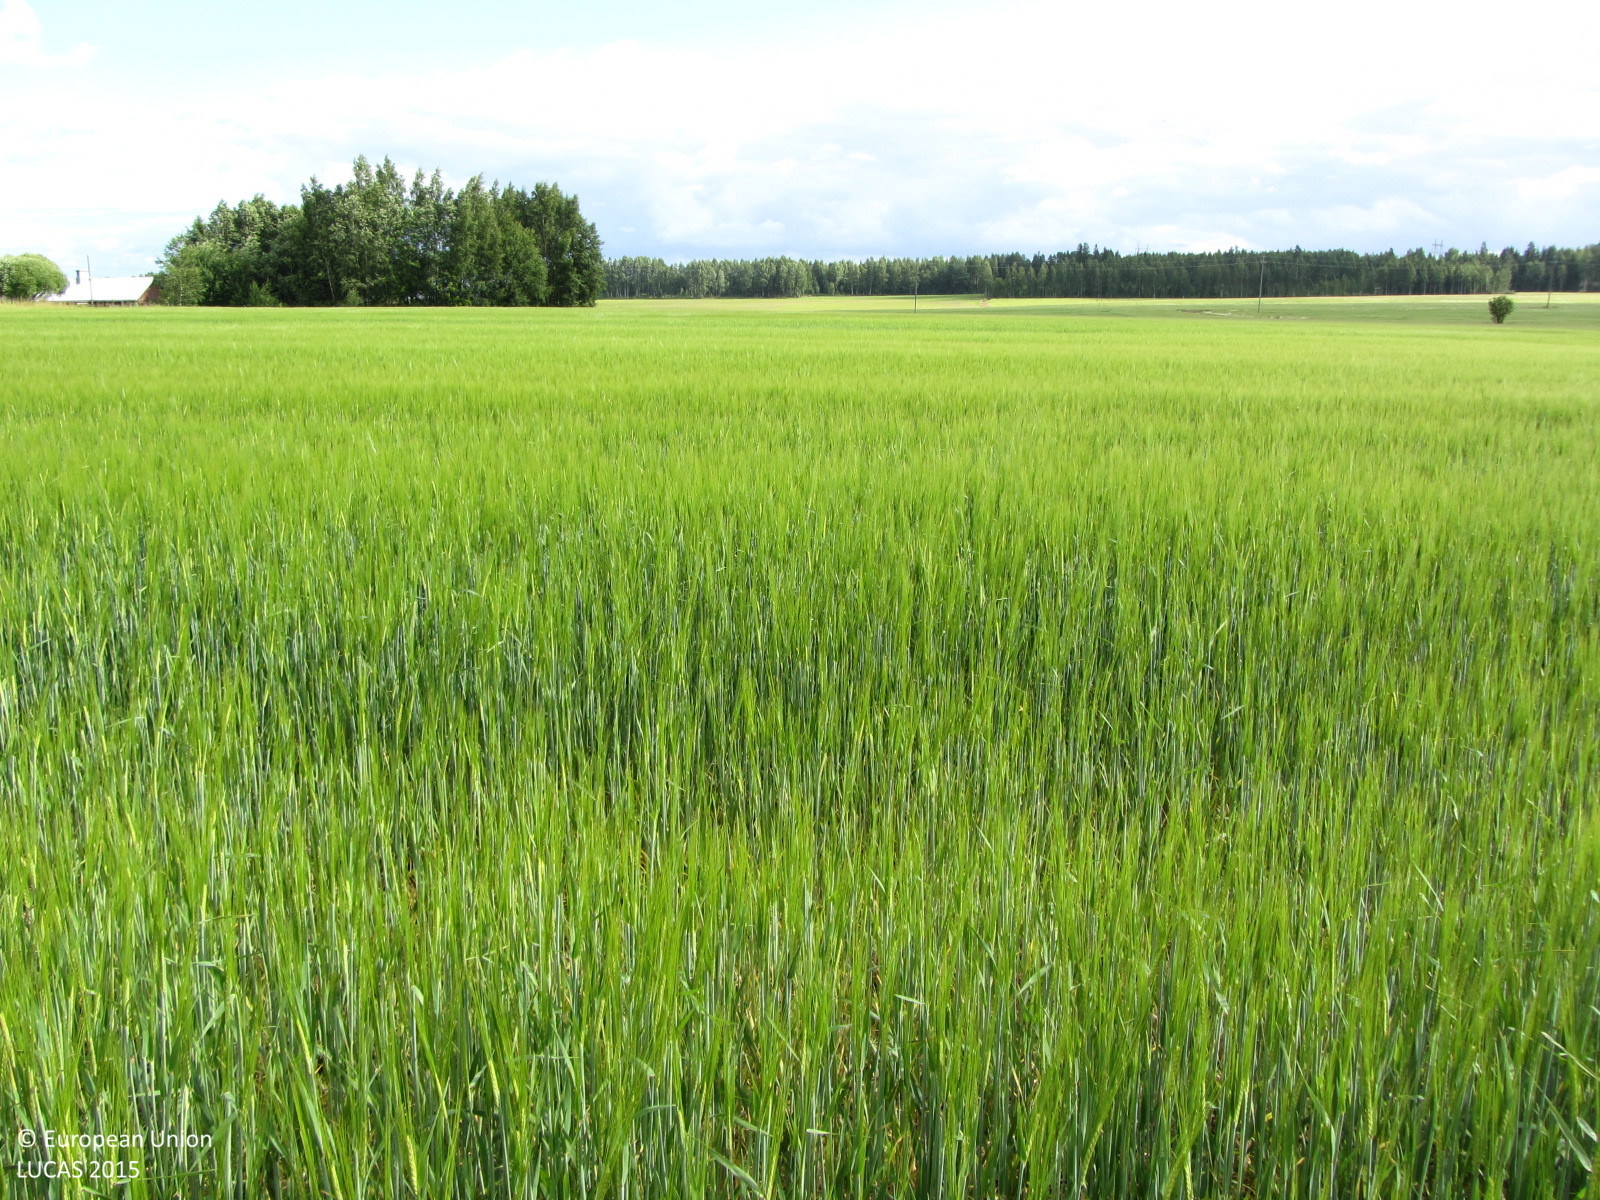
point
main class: Cropland
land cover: Barley
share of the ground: > 75 %
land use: Agriculture (excluding fallow land and kitchen gardens)
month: July
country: FI
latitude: 60.5017
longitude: 24.9173
